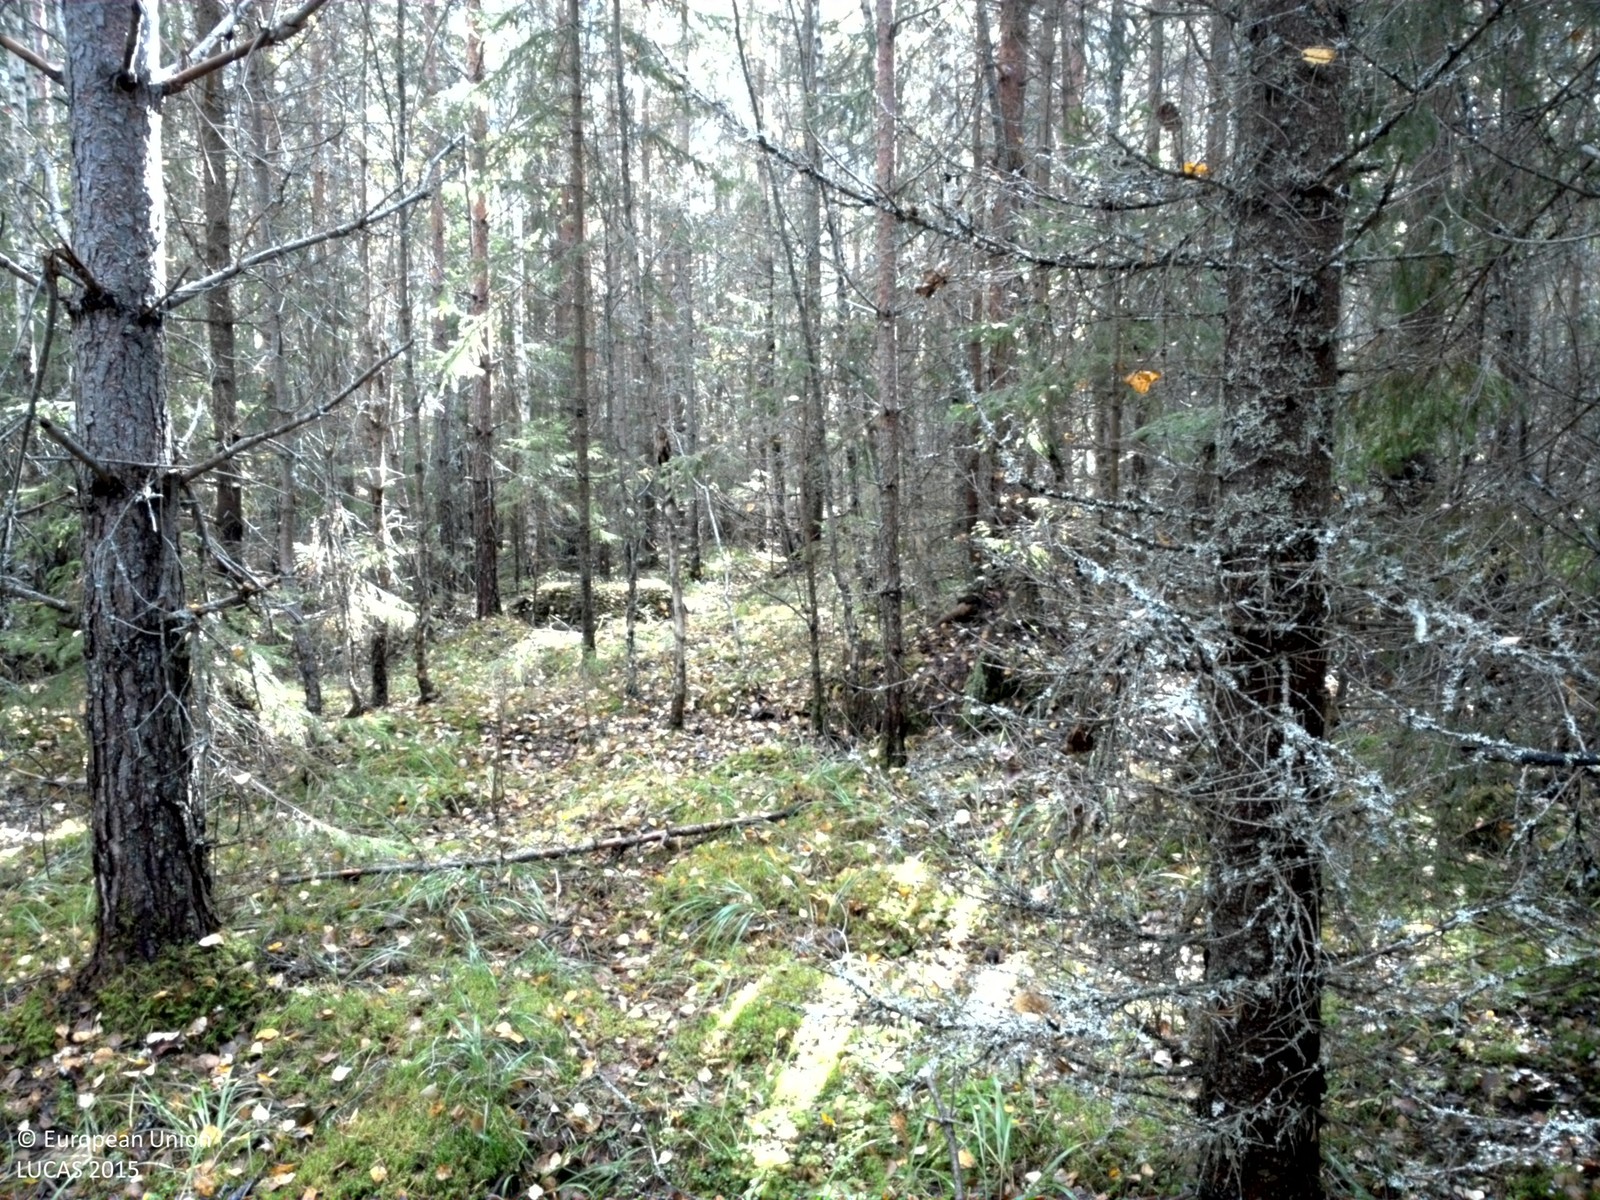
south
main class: Woodland
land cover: Pine dominated mixed woodland
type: boreal forest
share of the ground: 50 - 75 %
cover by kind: coniferous forest trees 45 %, lichens and mosses 30 %, broadleaved forest trees 15 %, herbaceous plants 10 %
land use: Forestry
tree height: > 5 m
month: September
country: SE
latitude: 60.1218
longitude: 16.4867
